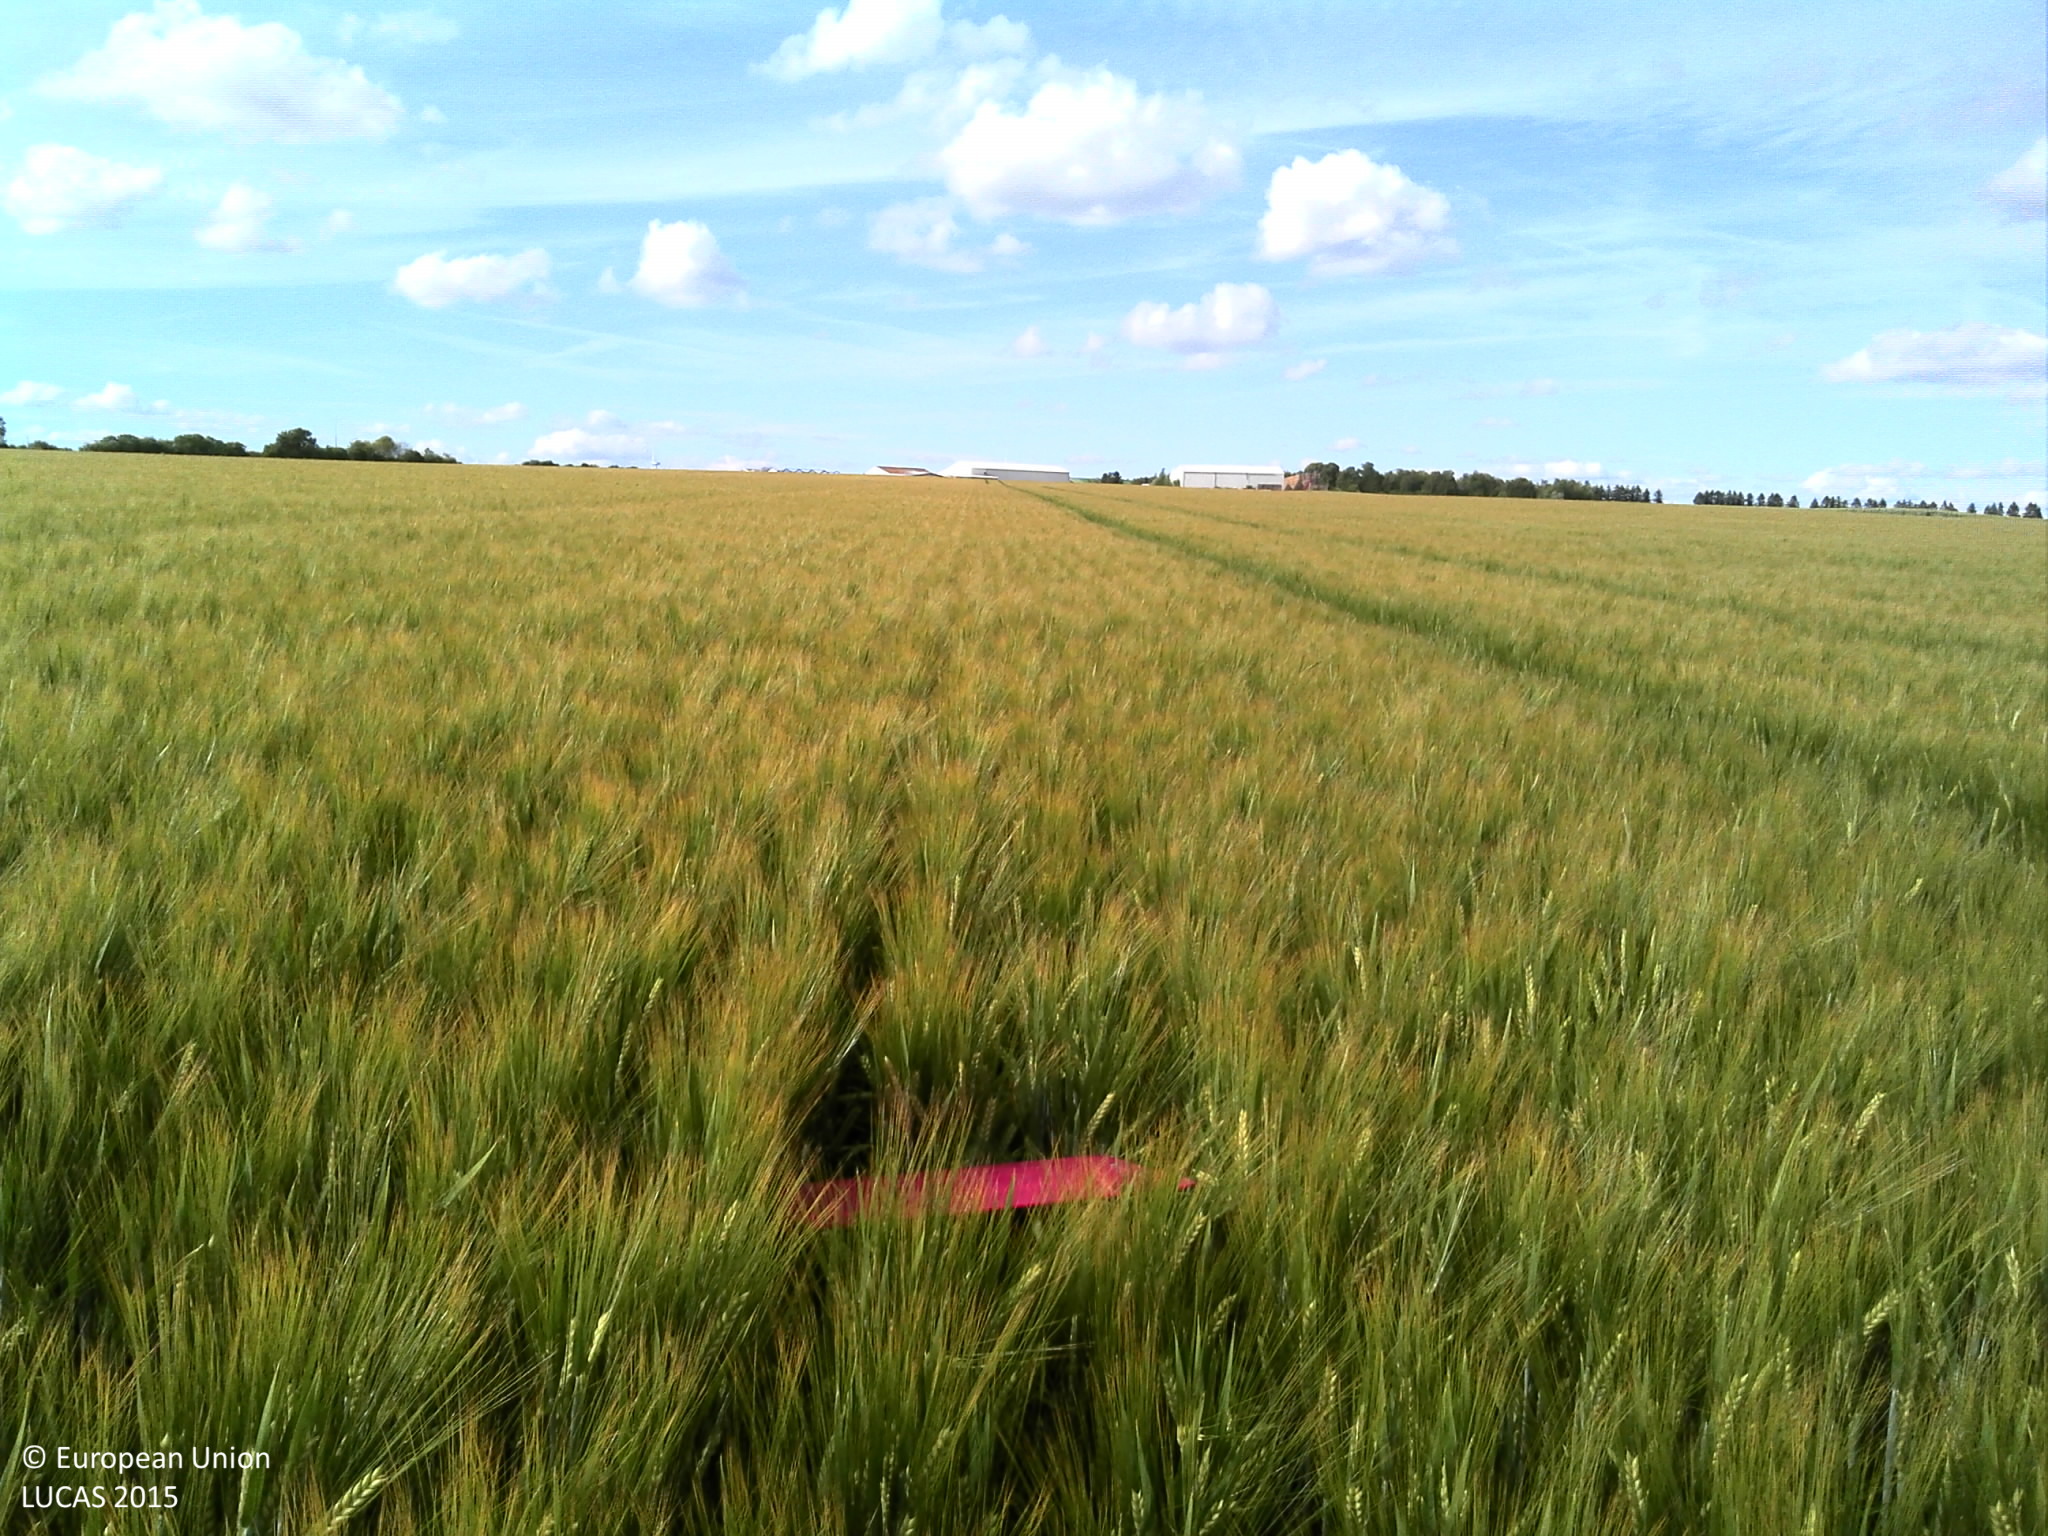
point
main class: Cropland
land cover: Barley
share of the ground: > 75 %
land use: Agriculture (excluding fallow land and kitchen gardens)
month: June
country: FR
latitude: 48.6274
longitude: 4.1484
